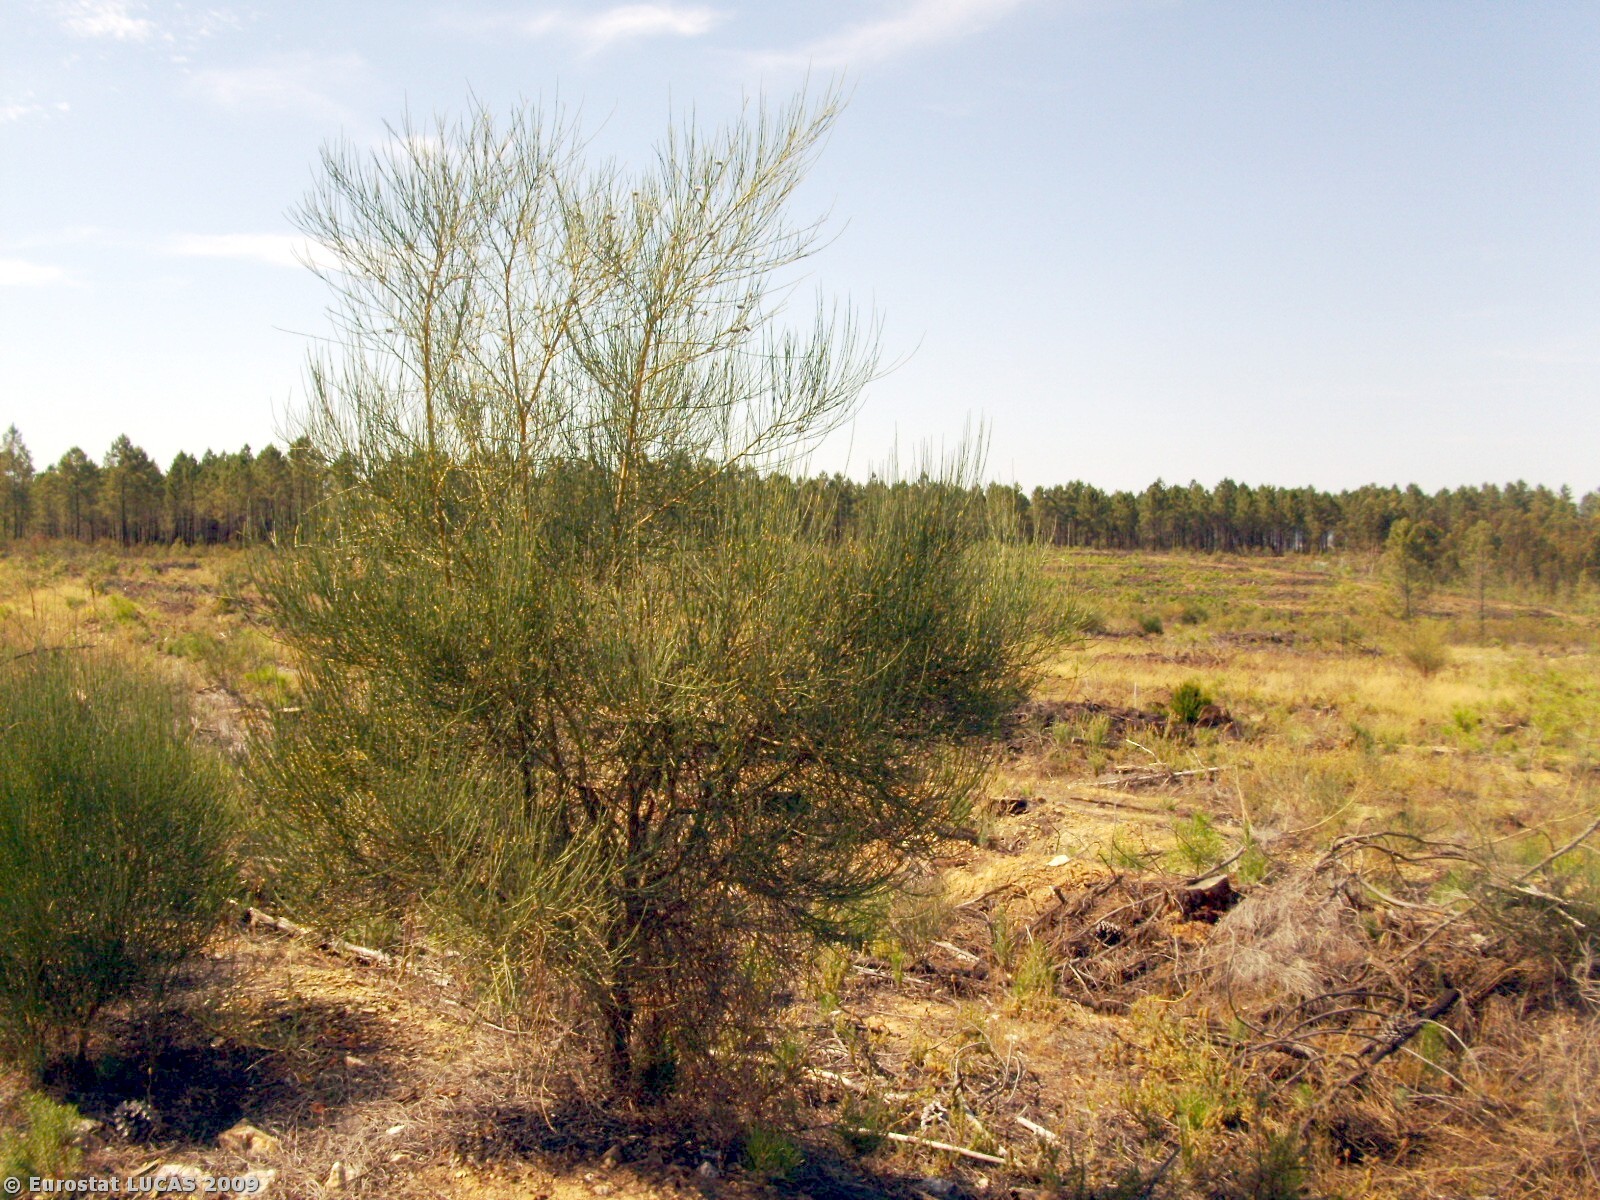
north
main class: Woodland
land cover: Coniferous woodland
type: coniferous forest of the mediterranean region
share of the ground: 25 - 50 %
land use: Forestry
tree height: > 5 m
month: July
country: PT
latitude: 40.0414
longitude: -6.9078
